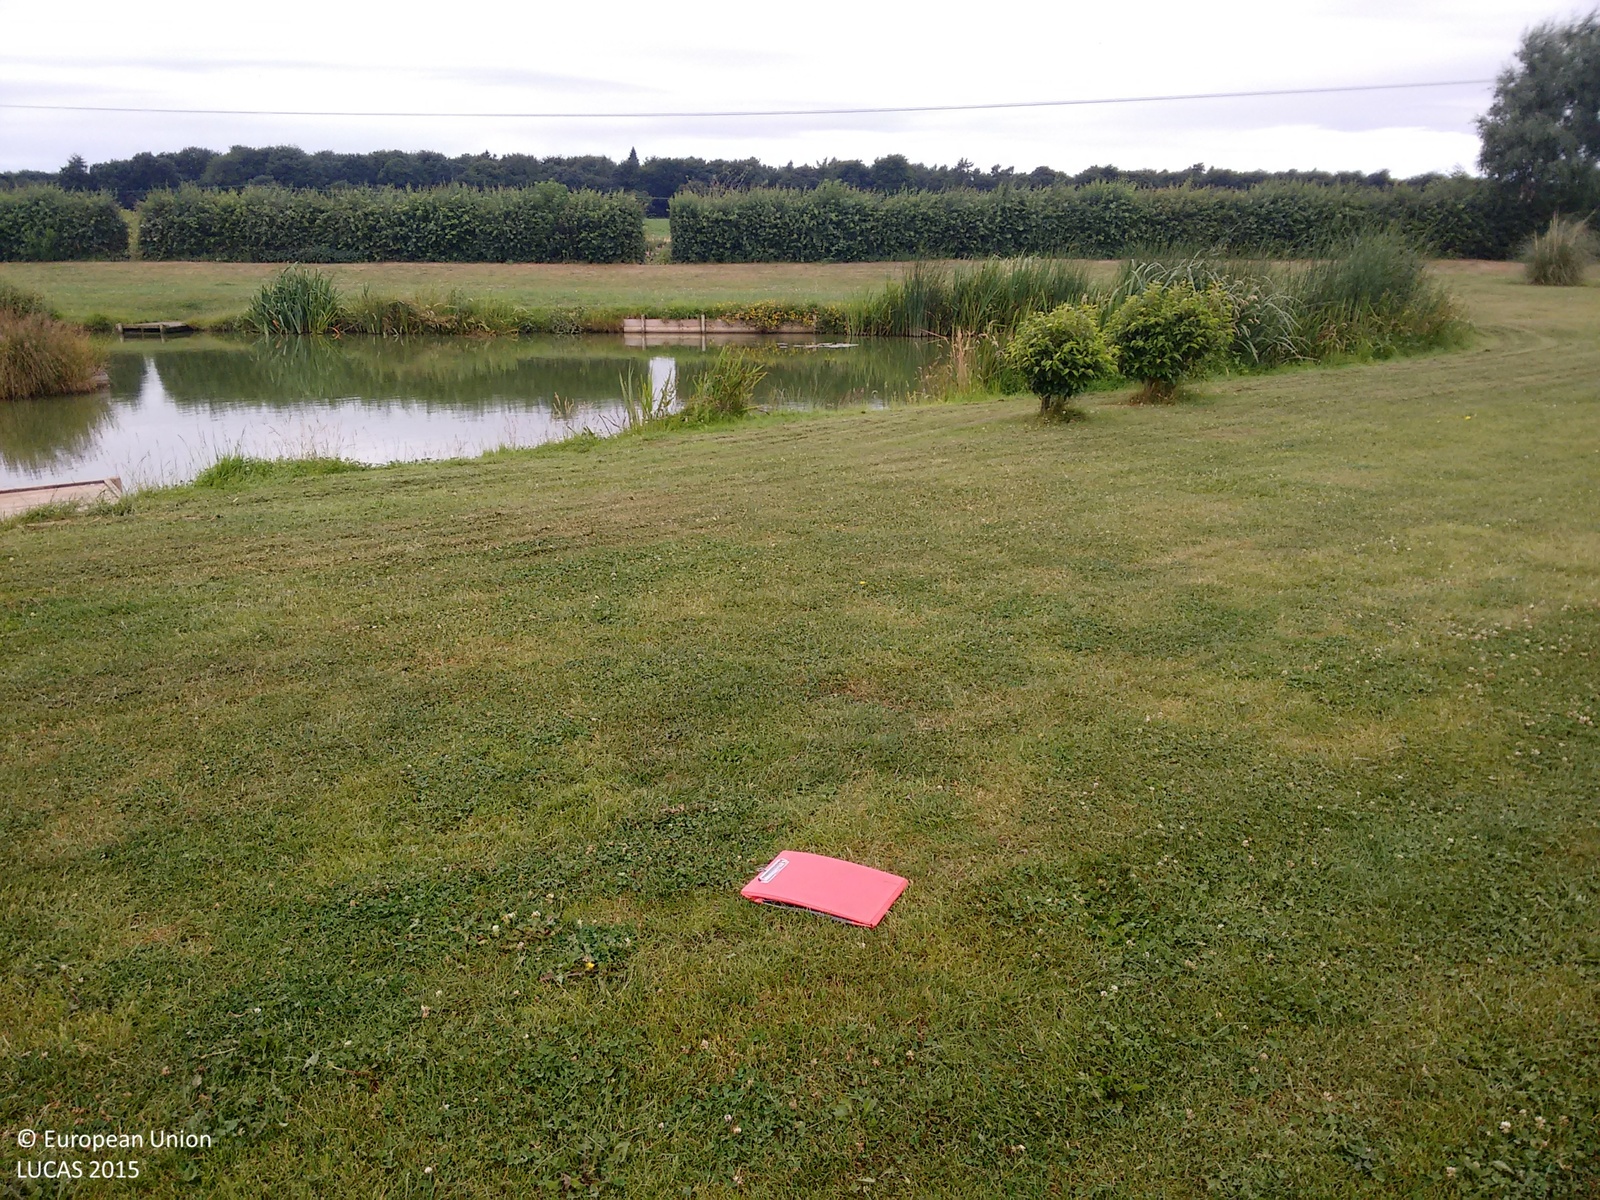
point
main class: Grassland
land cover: Grassland without tree/shrub cover
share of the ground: > 75 %
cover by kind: herbaceous plants 100 %
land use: Amenities, museums, leisure
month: July
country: GB
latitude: 53.2060
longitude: -1.0184
